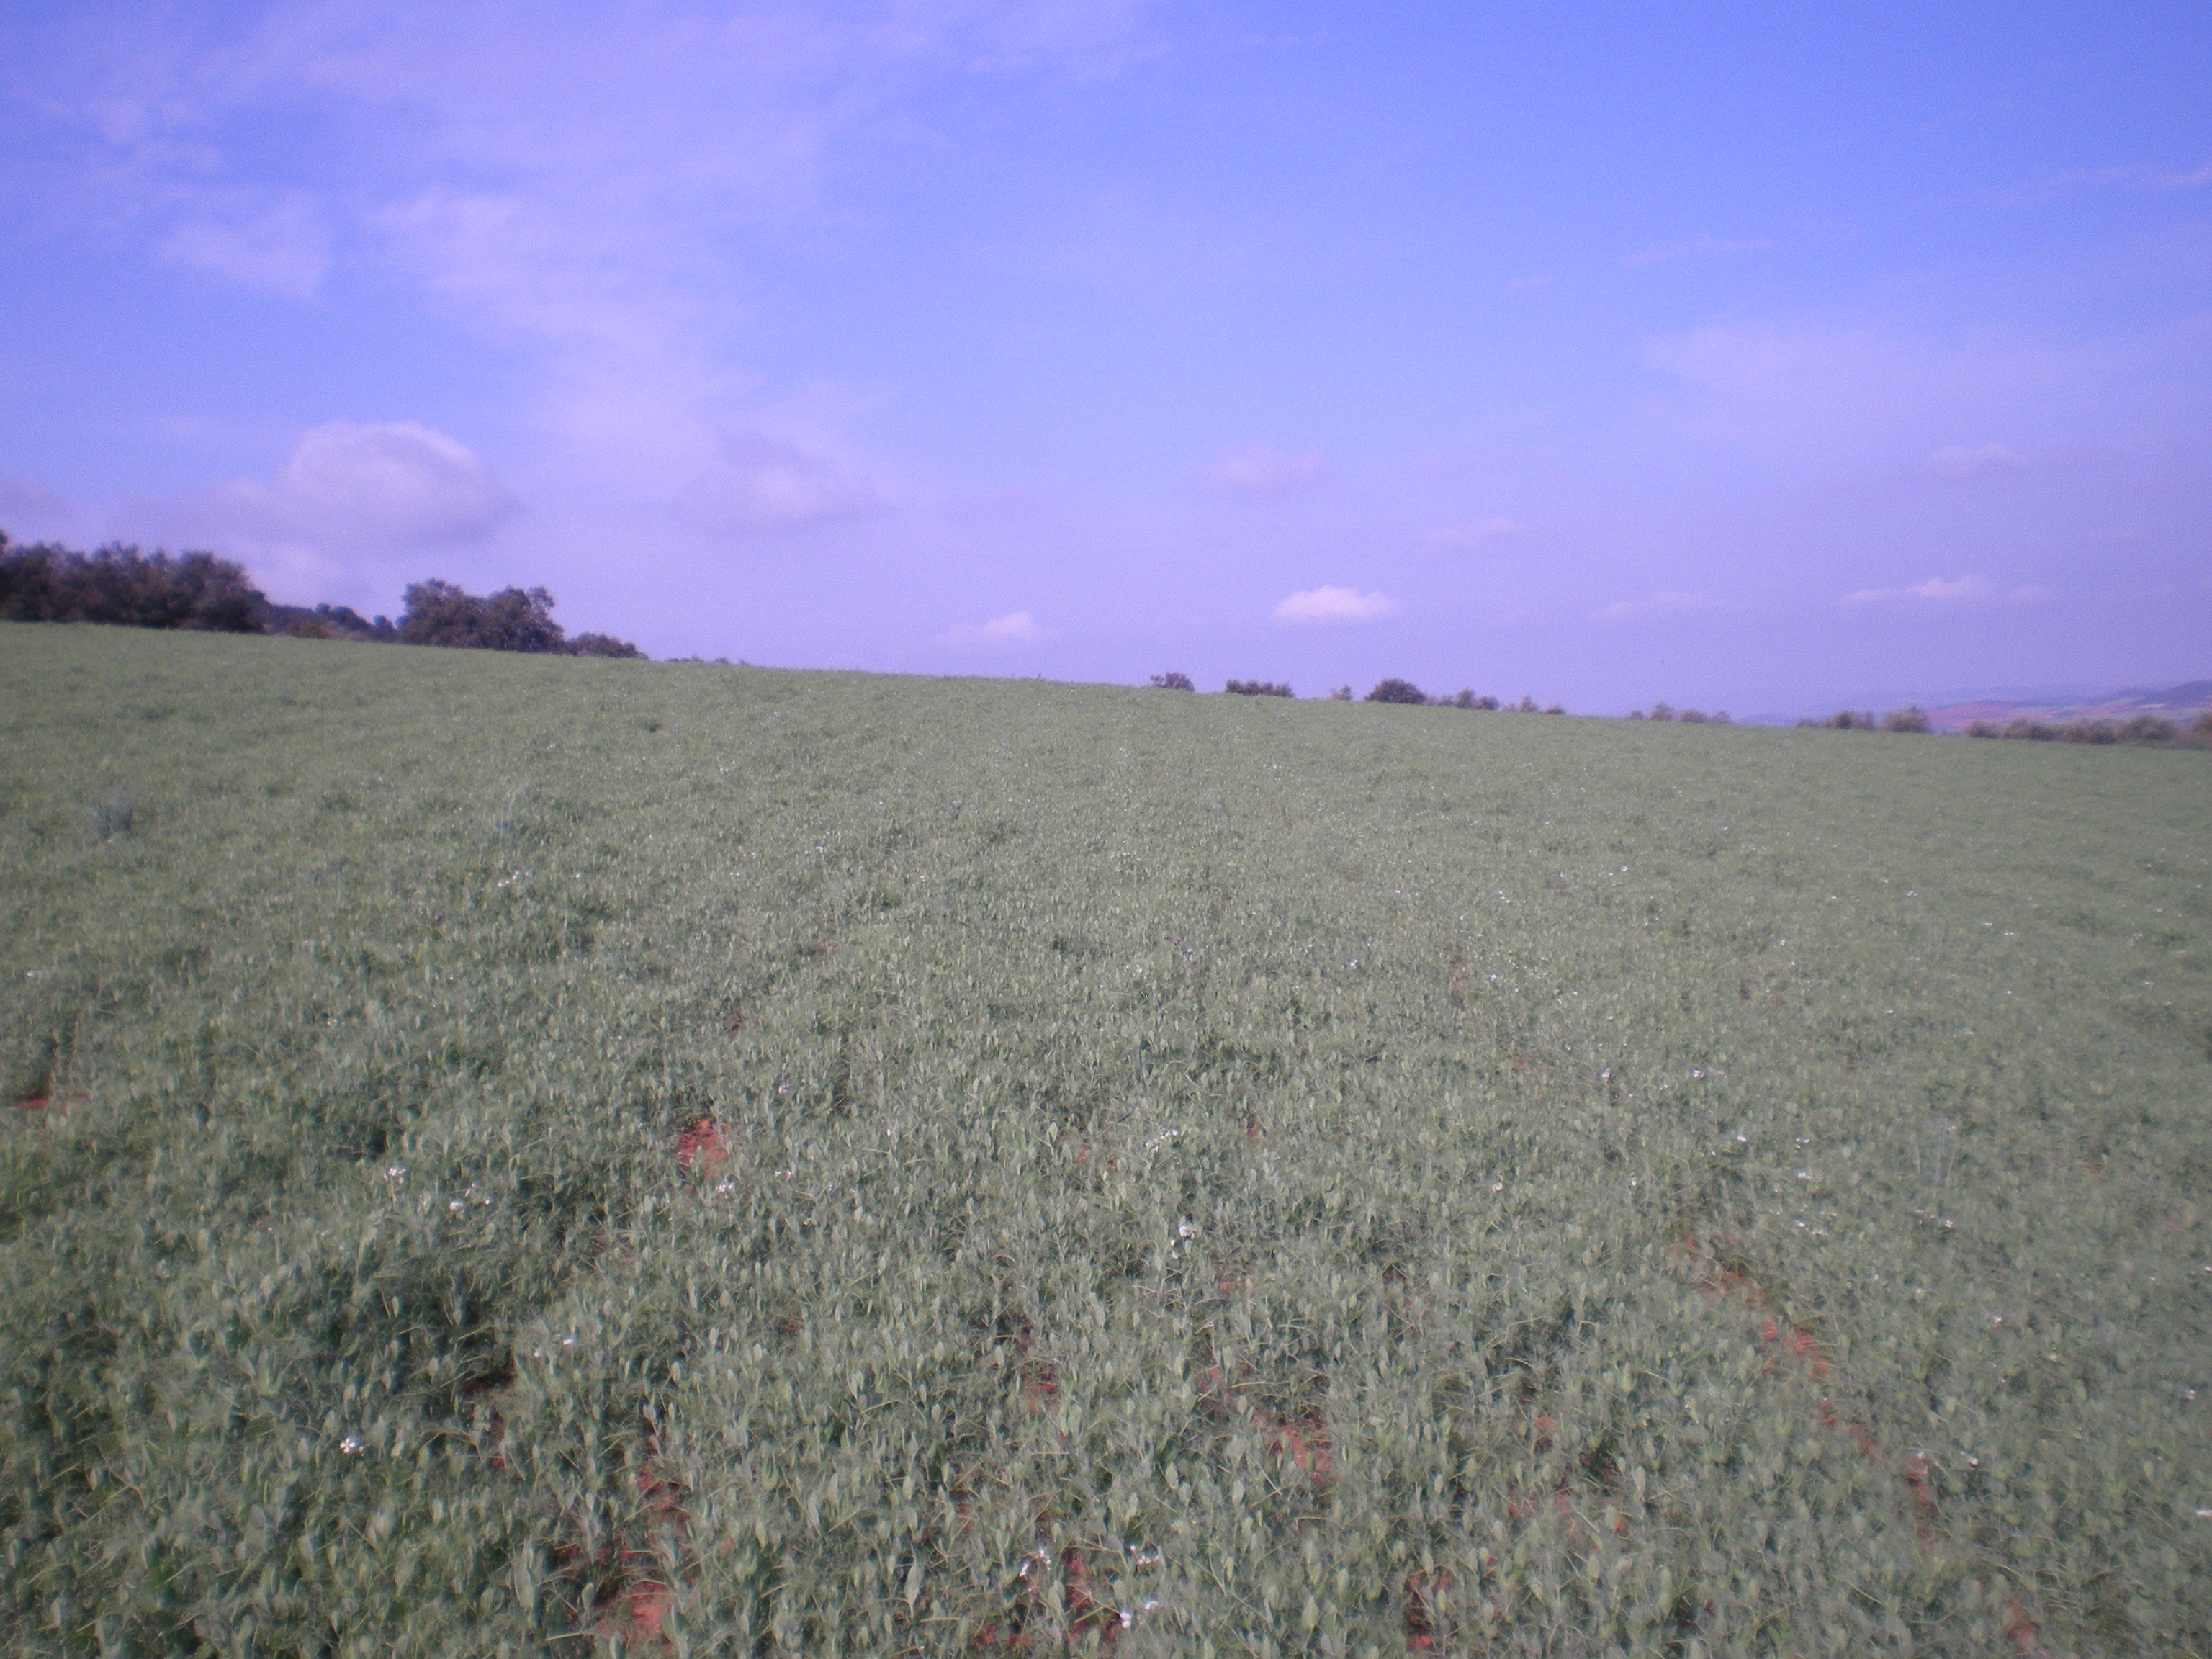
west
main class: Cropland
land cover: Dry pulses
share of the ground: > 75 %
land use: Agriculture (excluding fallow land and kitchen gardens)
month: April
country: ES
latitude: 38.5849
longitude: -3.4521
